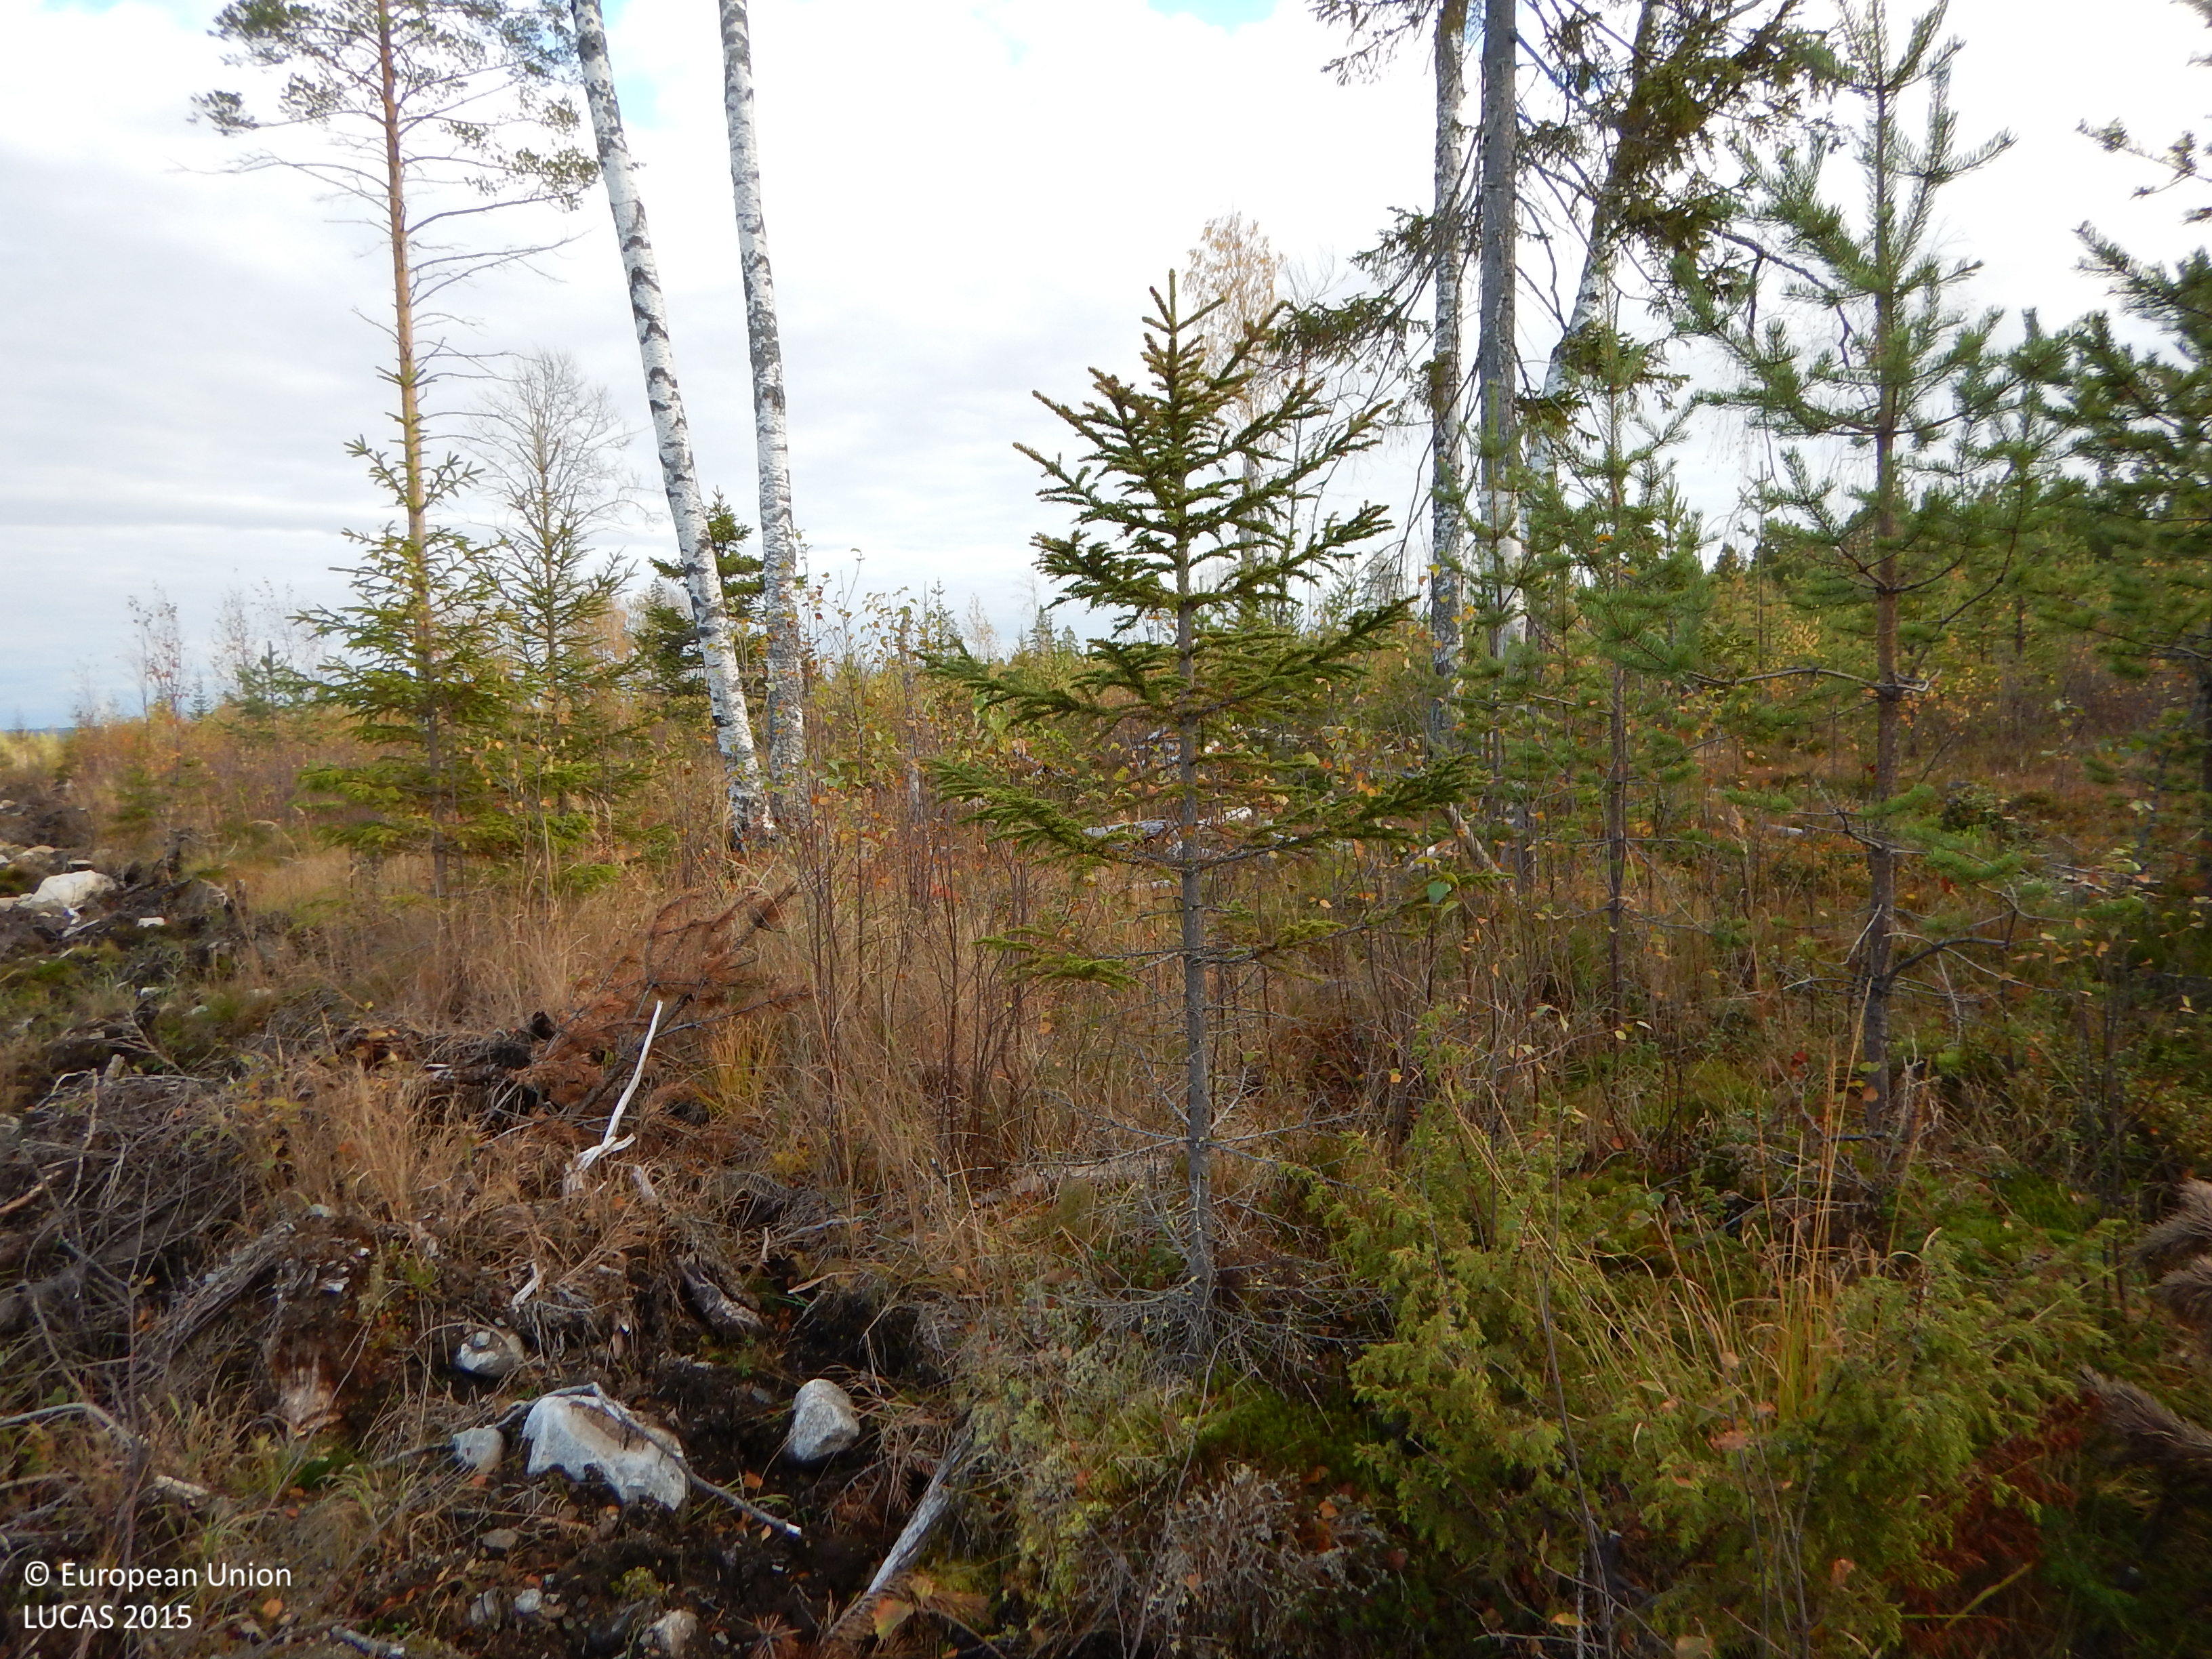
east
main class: Woodland
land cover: Other mixed woodland
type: boreal forest
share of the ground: 50 - 75 %
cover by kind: coniferous forest trees 45 %, broadleaved forest trees 25 %, herbaceous plants 15 %, shrubs 10 %, lichens and mosses 5 %
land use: Forestry
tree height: < 5 m
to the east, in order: Other mixed woodland; Broadleaved woodland; Other mixed woodland
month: October
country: SE
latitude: 64.9822
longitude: 21.0174
